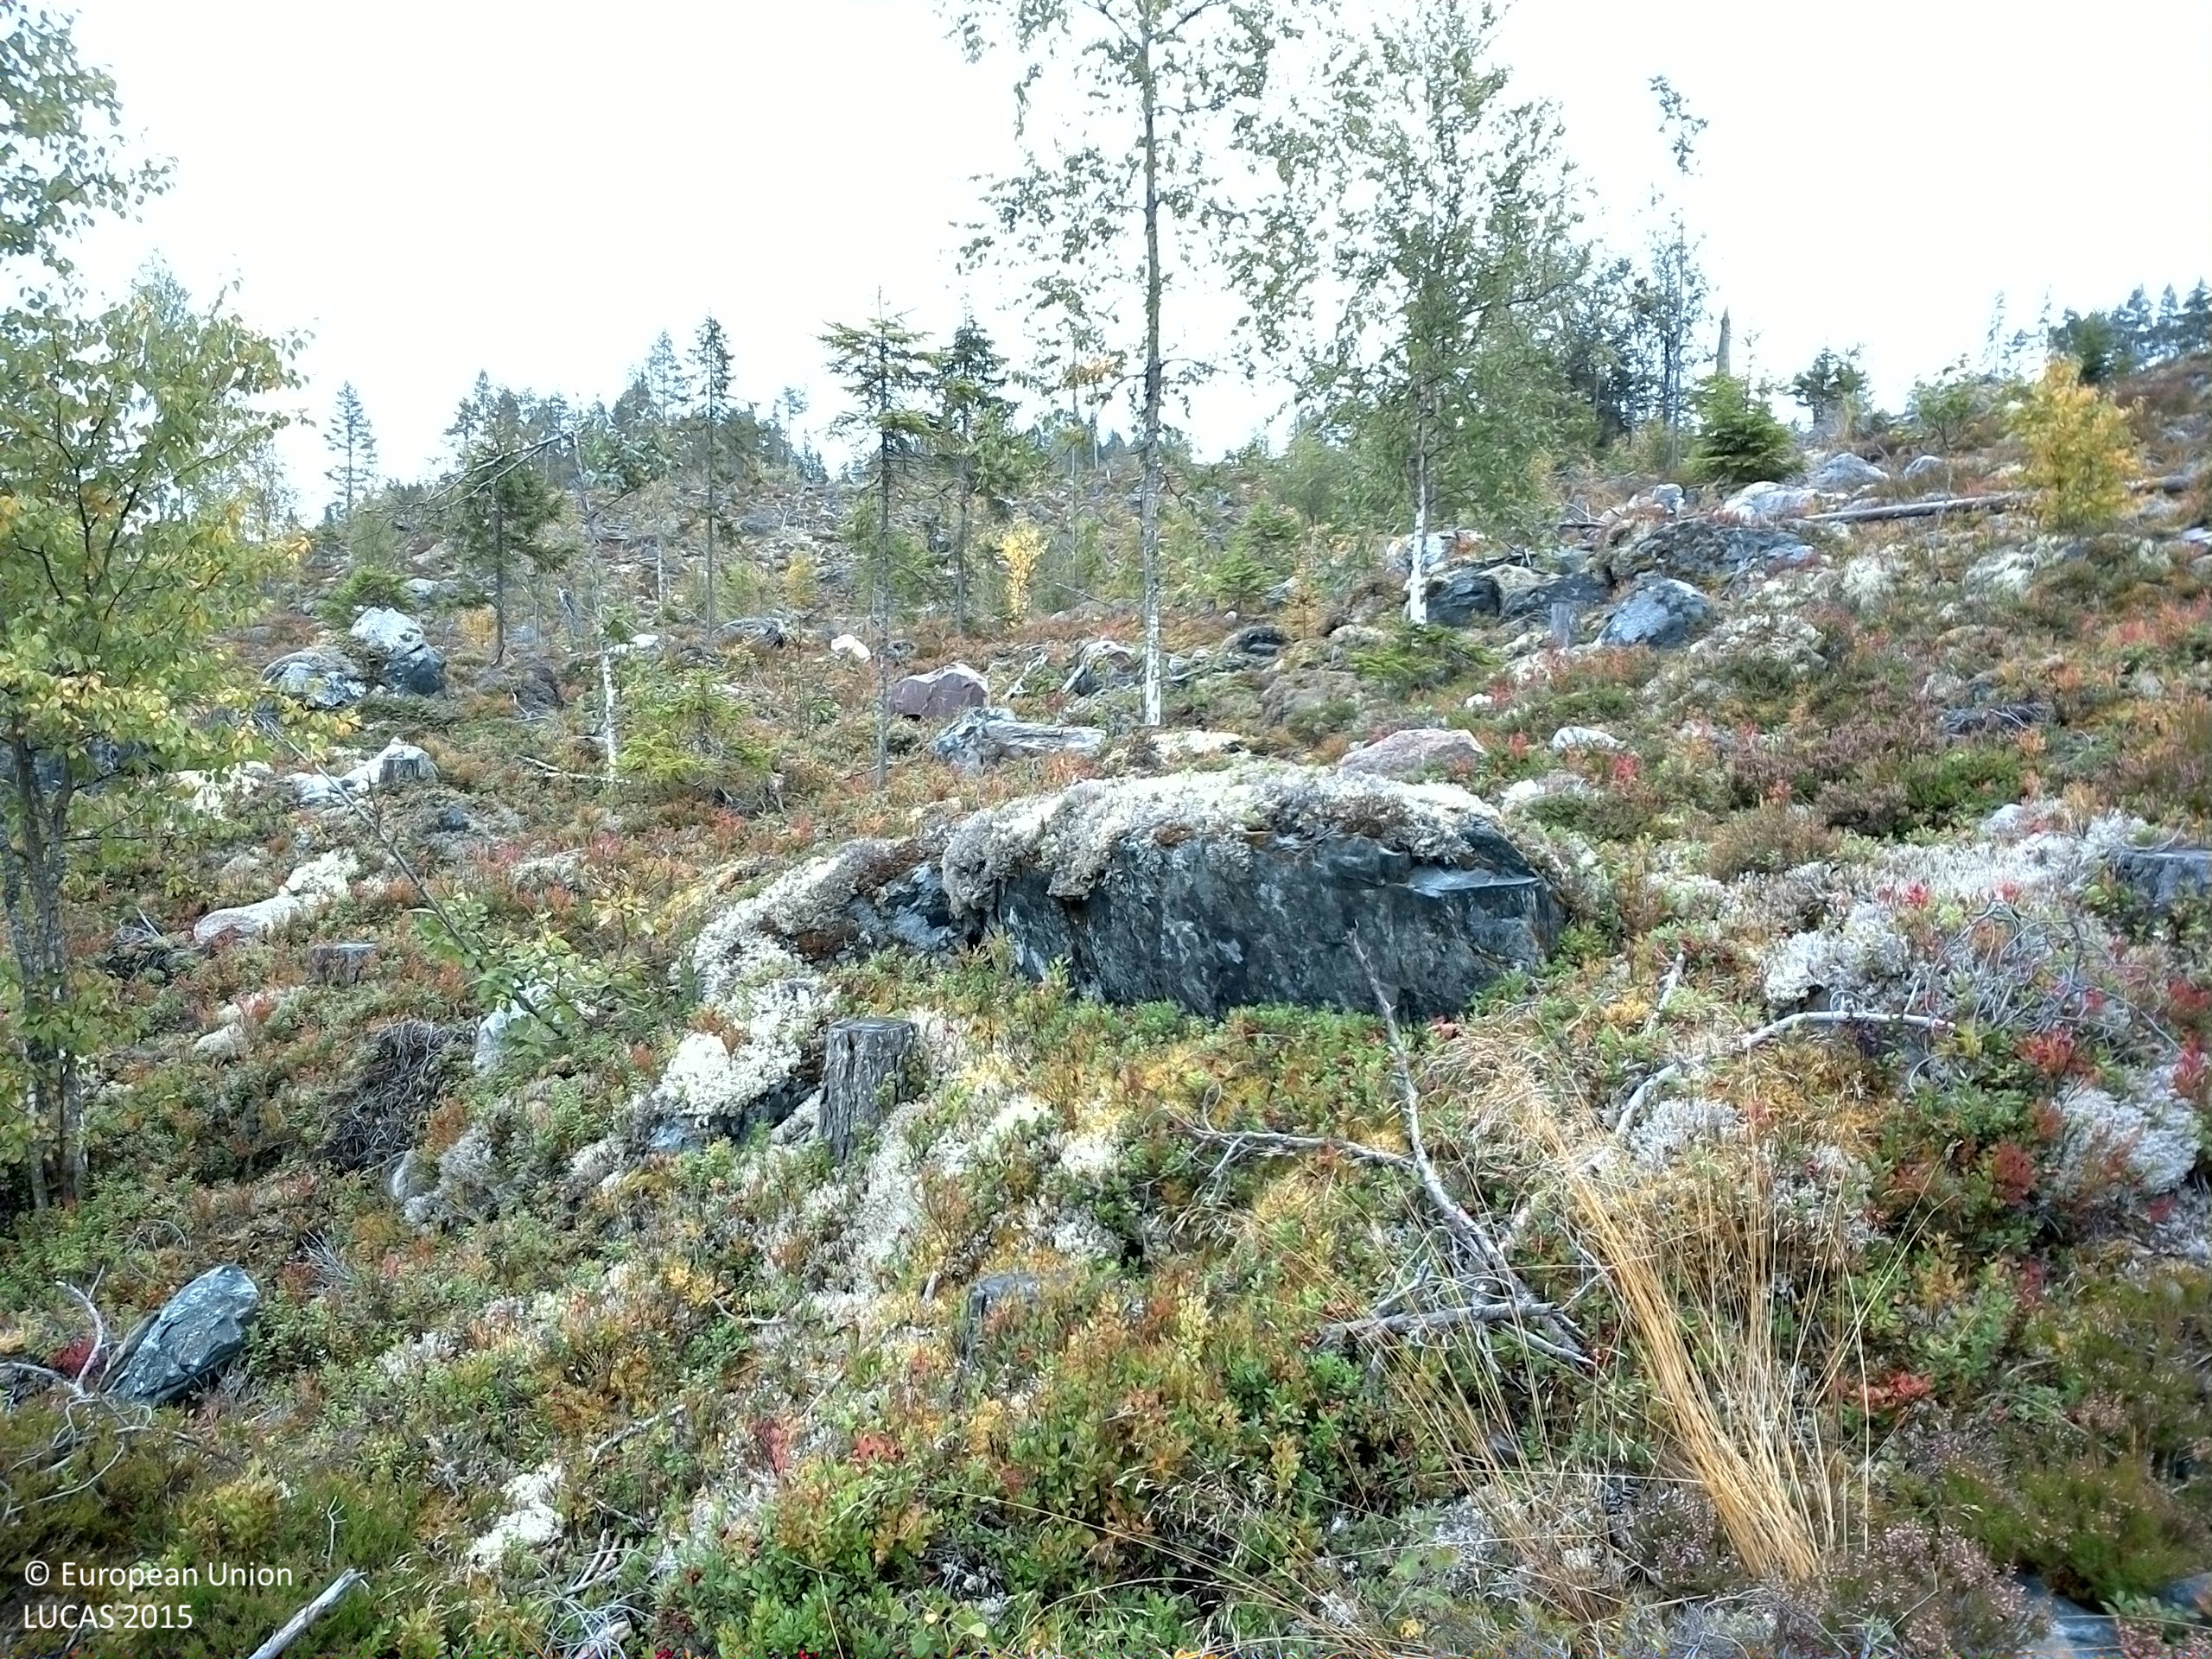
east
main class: Woodland
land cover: Other mixed woodland
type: boreal forest
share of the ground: 10 - 25 %
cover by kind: shrubs 45 %, lichens and mosses 20 %, consolidated bare surface 20 %, broadleaved forest trees 10 %, coniferous forest trees 5 %
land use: Forestry
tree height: < 5 m
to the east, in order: Other mixed woodland; Shrubland without tree cover; Pine dominated coniferous woodland; Spruce dominated coniferous woodland
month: September
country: SE
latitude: 61.6037
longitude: 15.1297
